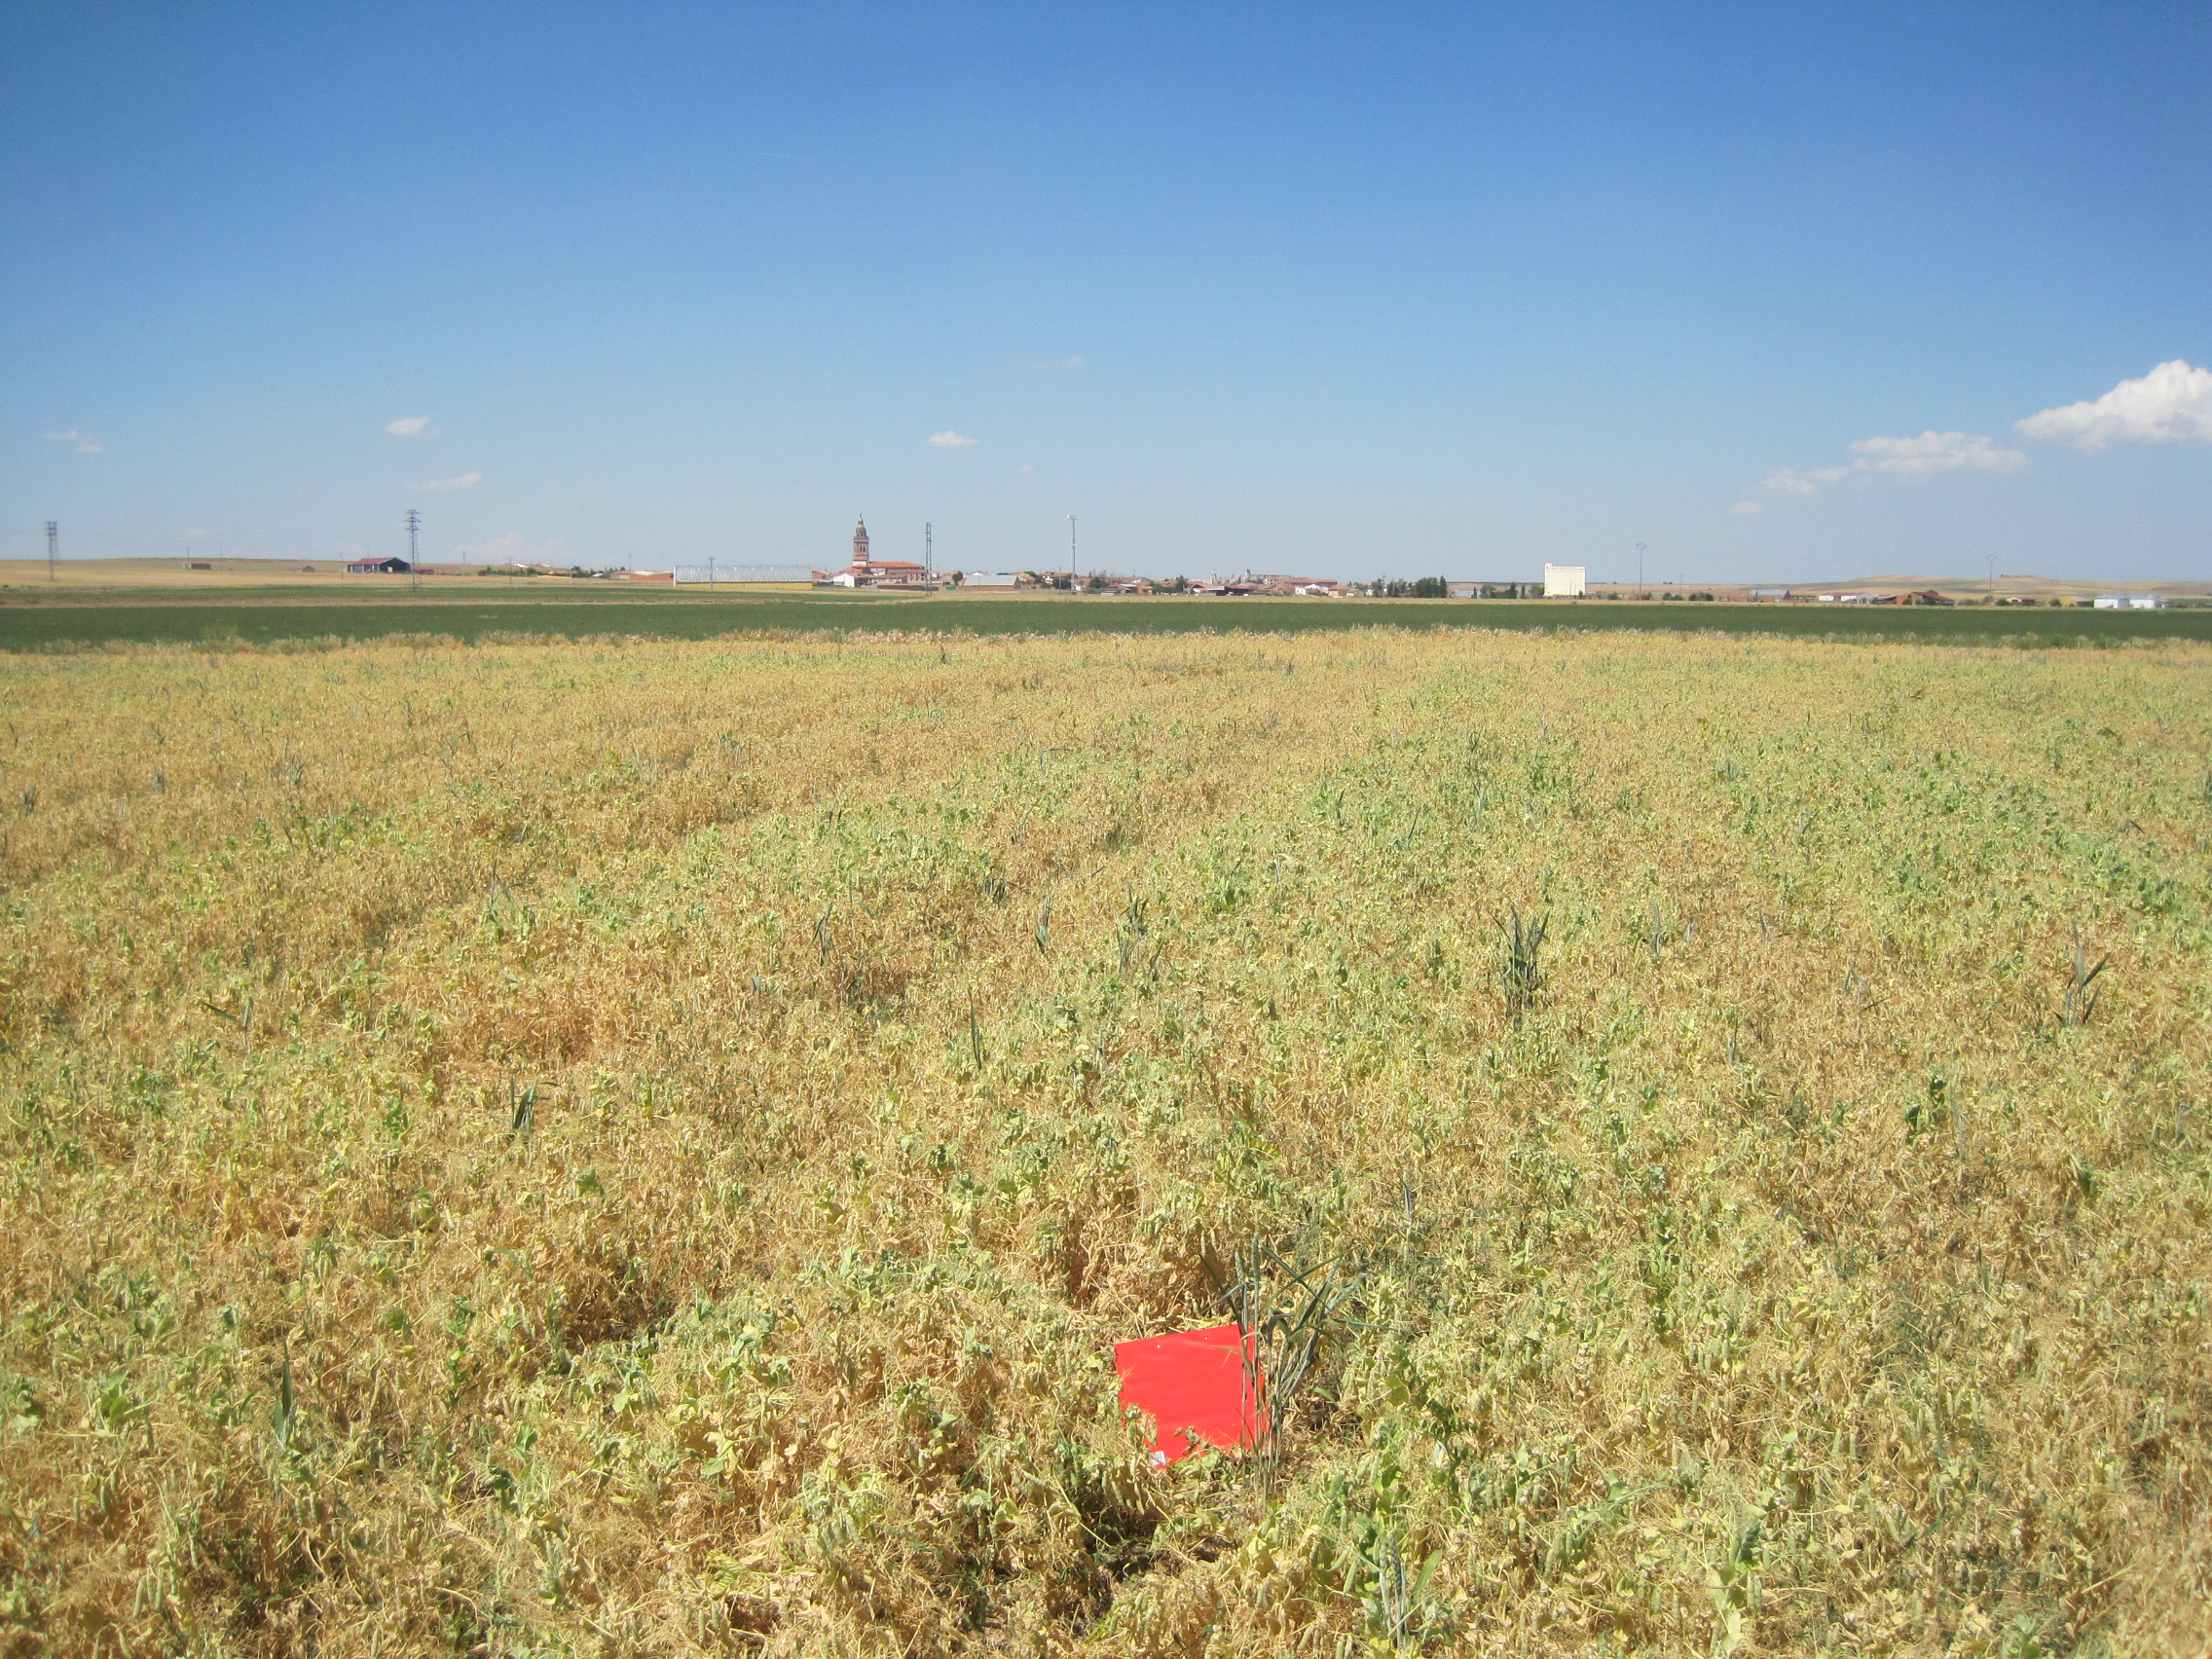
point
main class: Cropland
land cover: Dry pulses
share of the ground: > 75 %
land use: Agriculture (excluding fallow land and kitchen gardens)
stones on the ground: 10 - 25 %
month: May
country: ES
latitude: 41.3147
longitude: -5.0866
